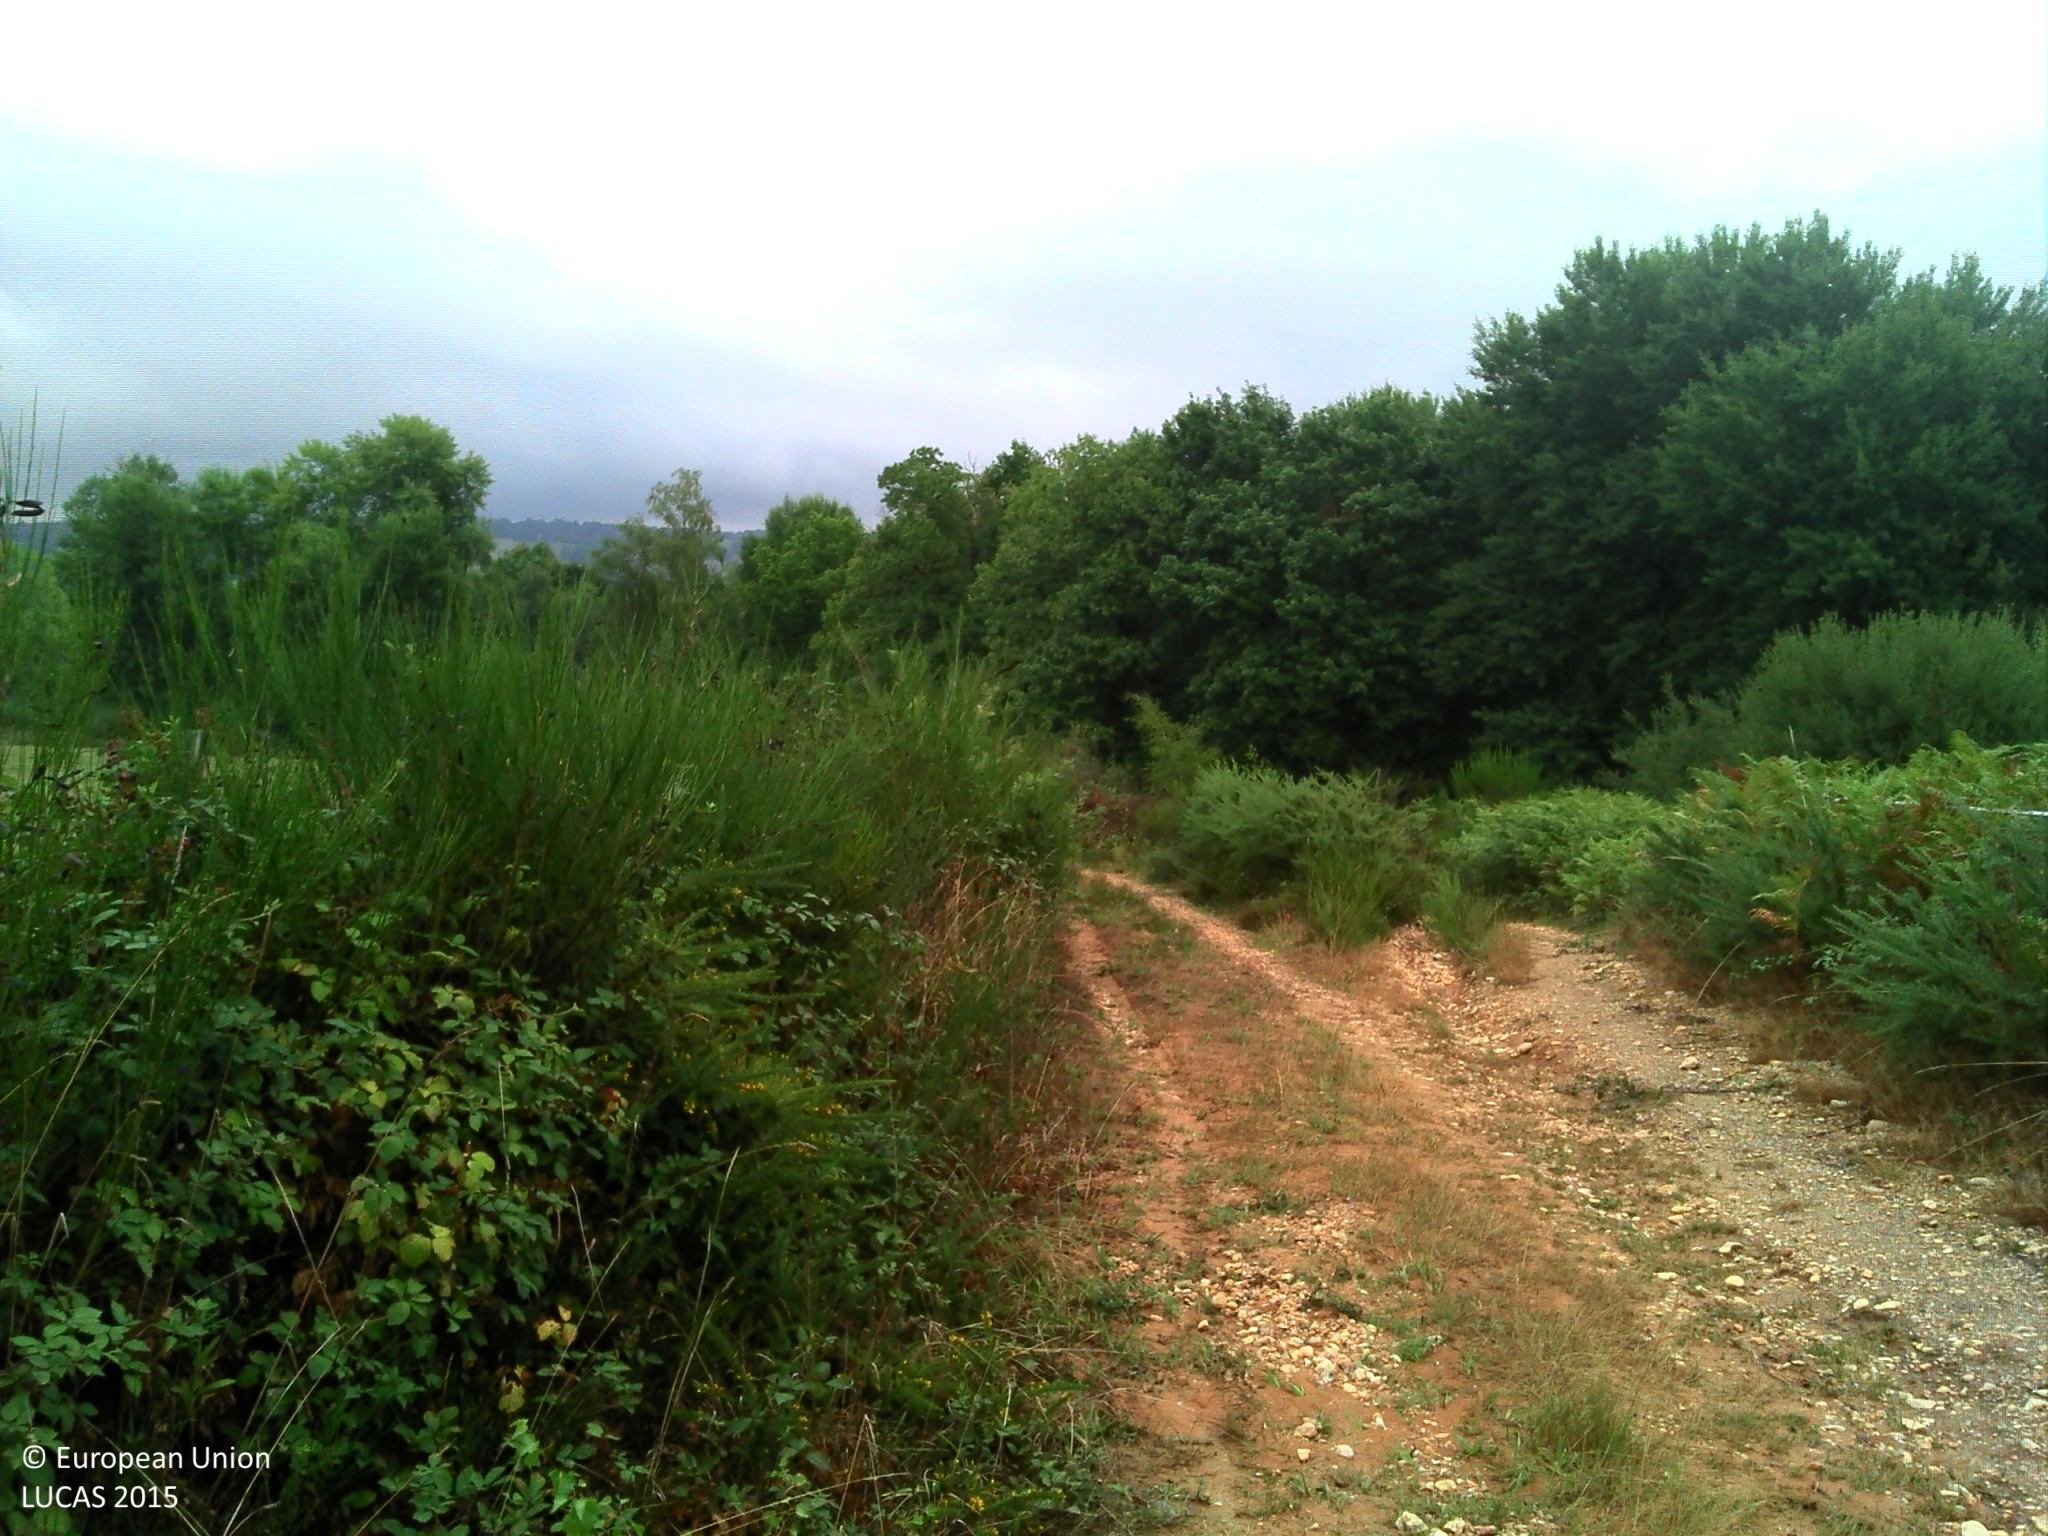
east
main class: Grassland
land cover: Grassland without tree/shrub cover
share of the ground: > 75 %
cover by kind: herbaceous plants 80 %, lichens and mosses 10 %, unconsolidated bare surface 10 %
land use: Agriculture (excluding fallow land and kitchen gardens)
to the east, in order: Grassland without tree/shrub cover; Fences; Broadleaved woodland; Tracks; Broadleaved woodland; Rivers and streams; Broadleaved woodland
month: August
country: FR
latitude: 45.5038
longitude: 1.0447
